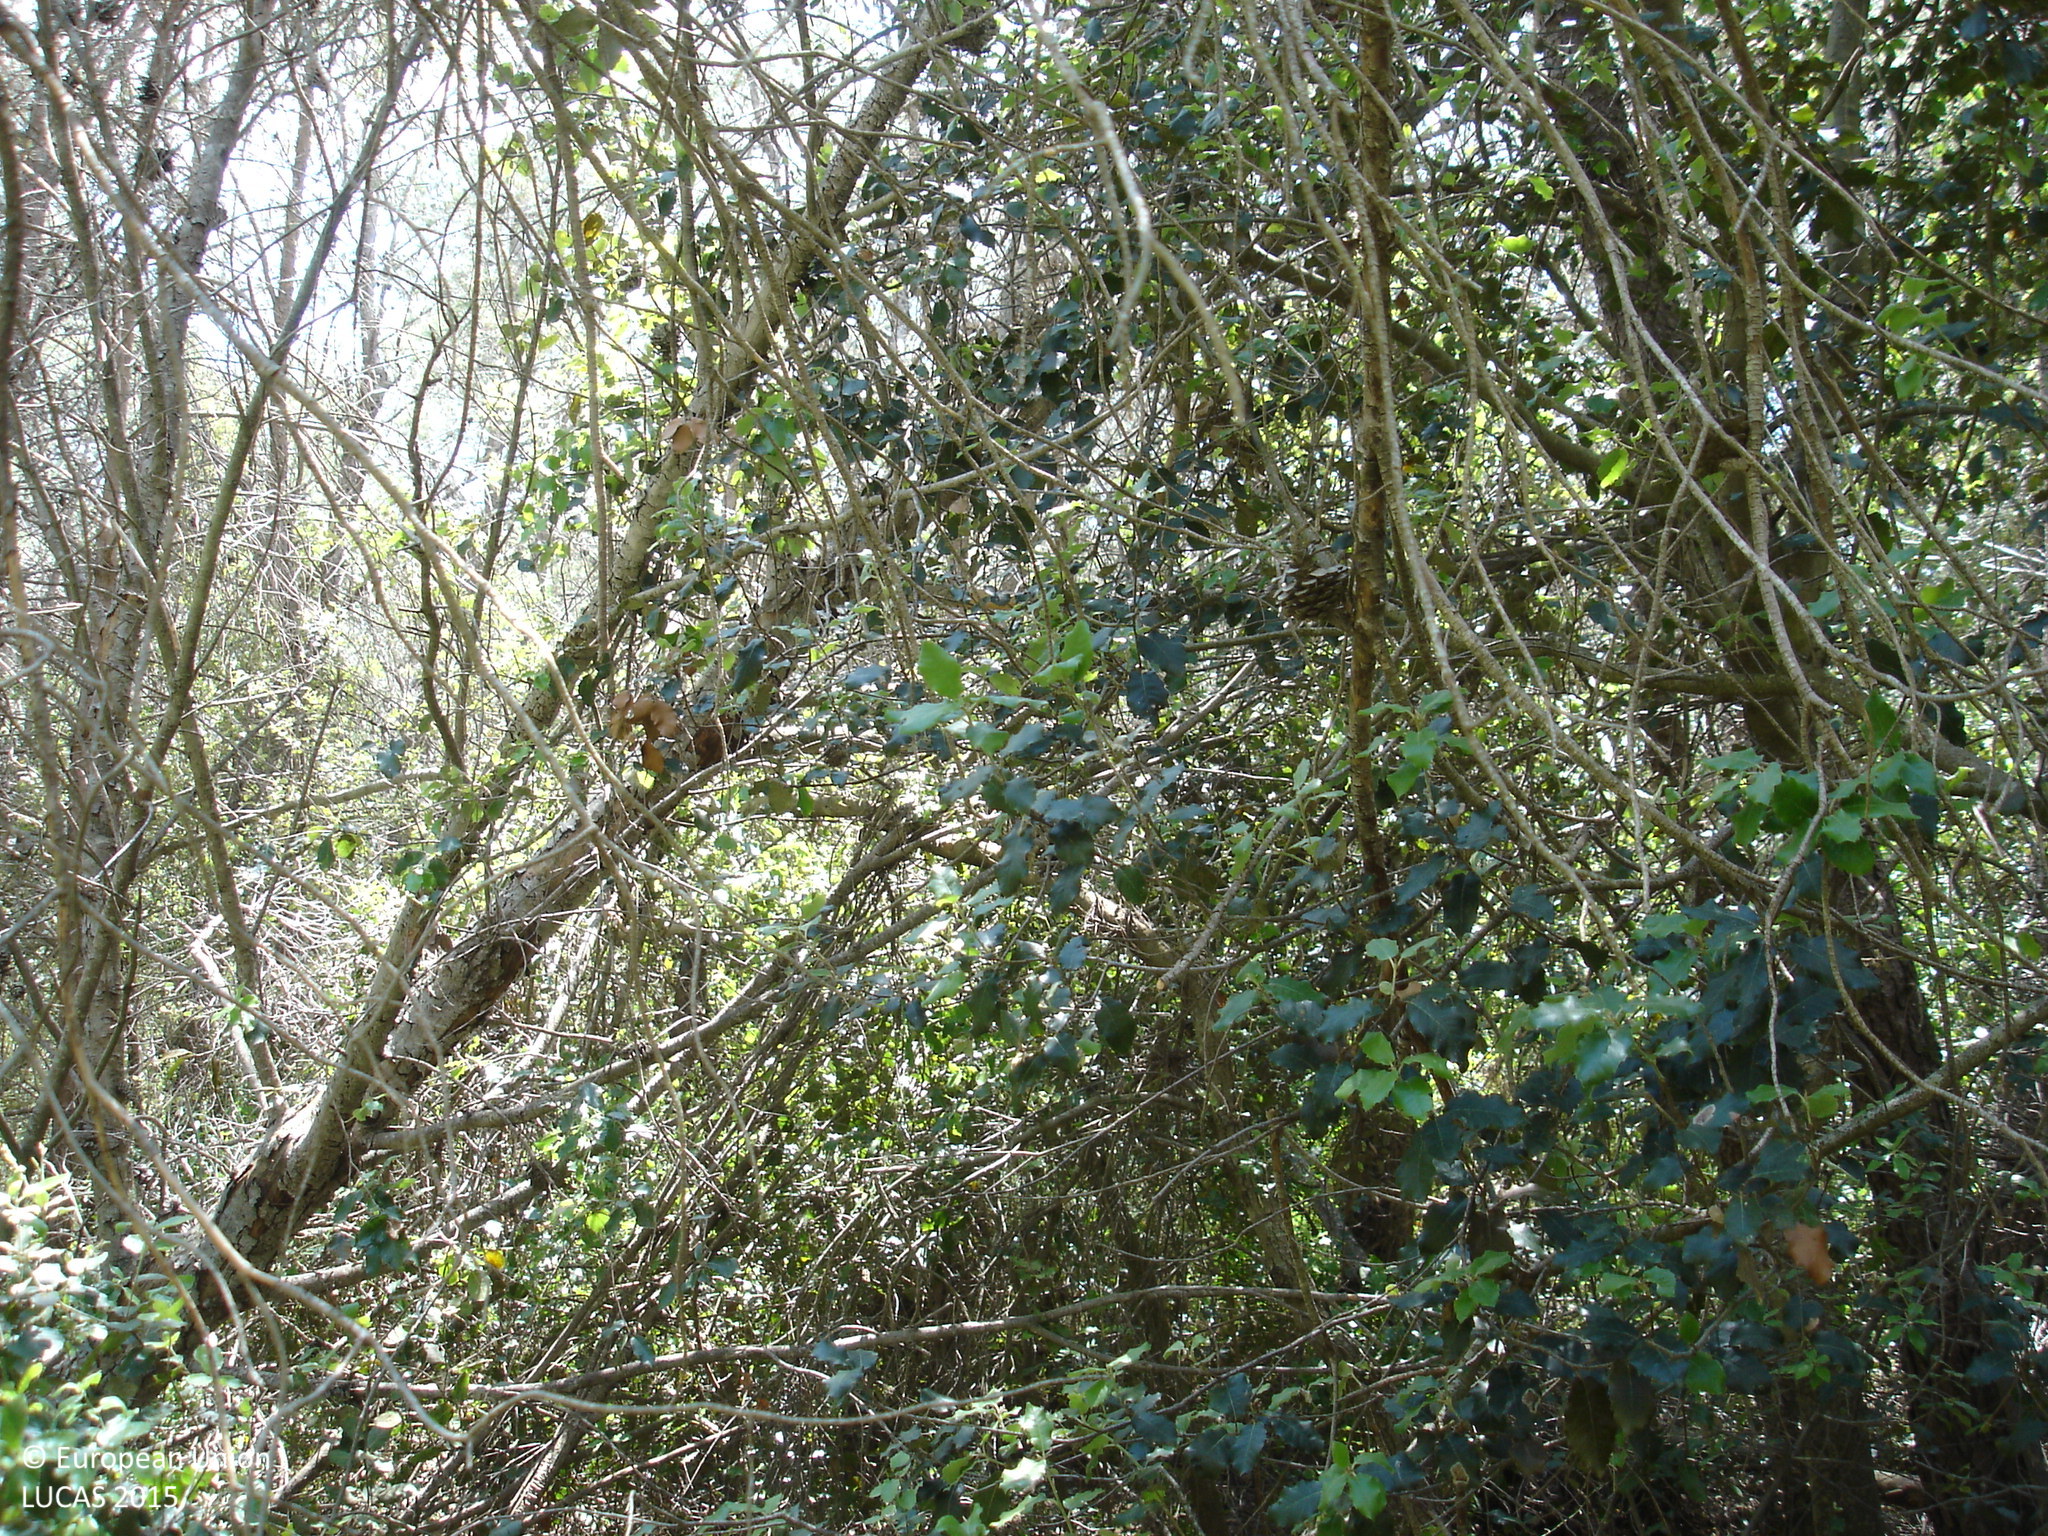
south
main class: Woodland
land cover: Pine dominated coniferous woodland
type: coniferous forest of the mediterranean region
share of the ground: > 75 %
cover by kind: coniferous forest trees 90 %, broadleaved forest trees 5 %, shrubs 5 %
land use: Forestry
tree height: > 5 m
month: May
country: ES
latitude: 42.1405
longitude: 3.0094
